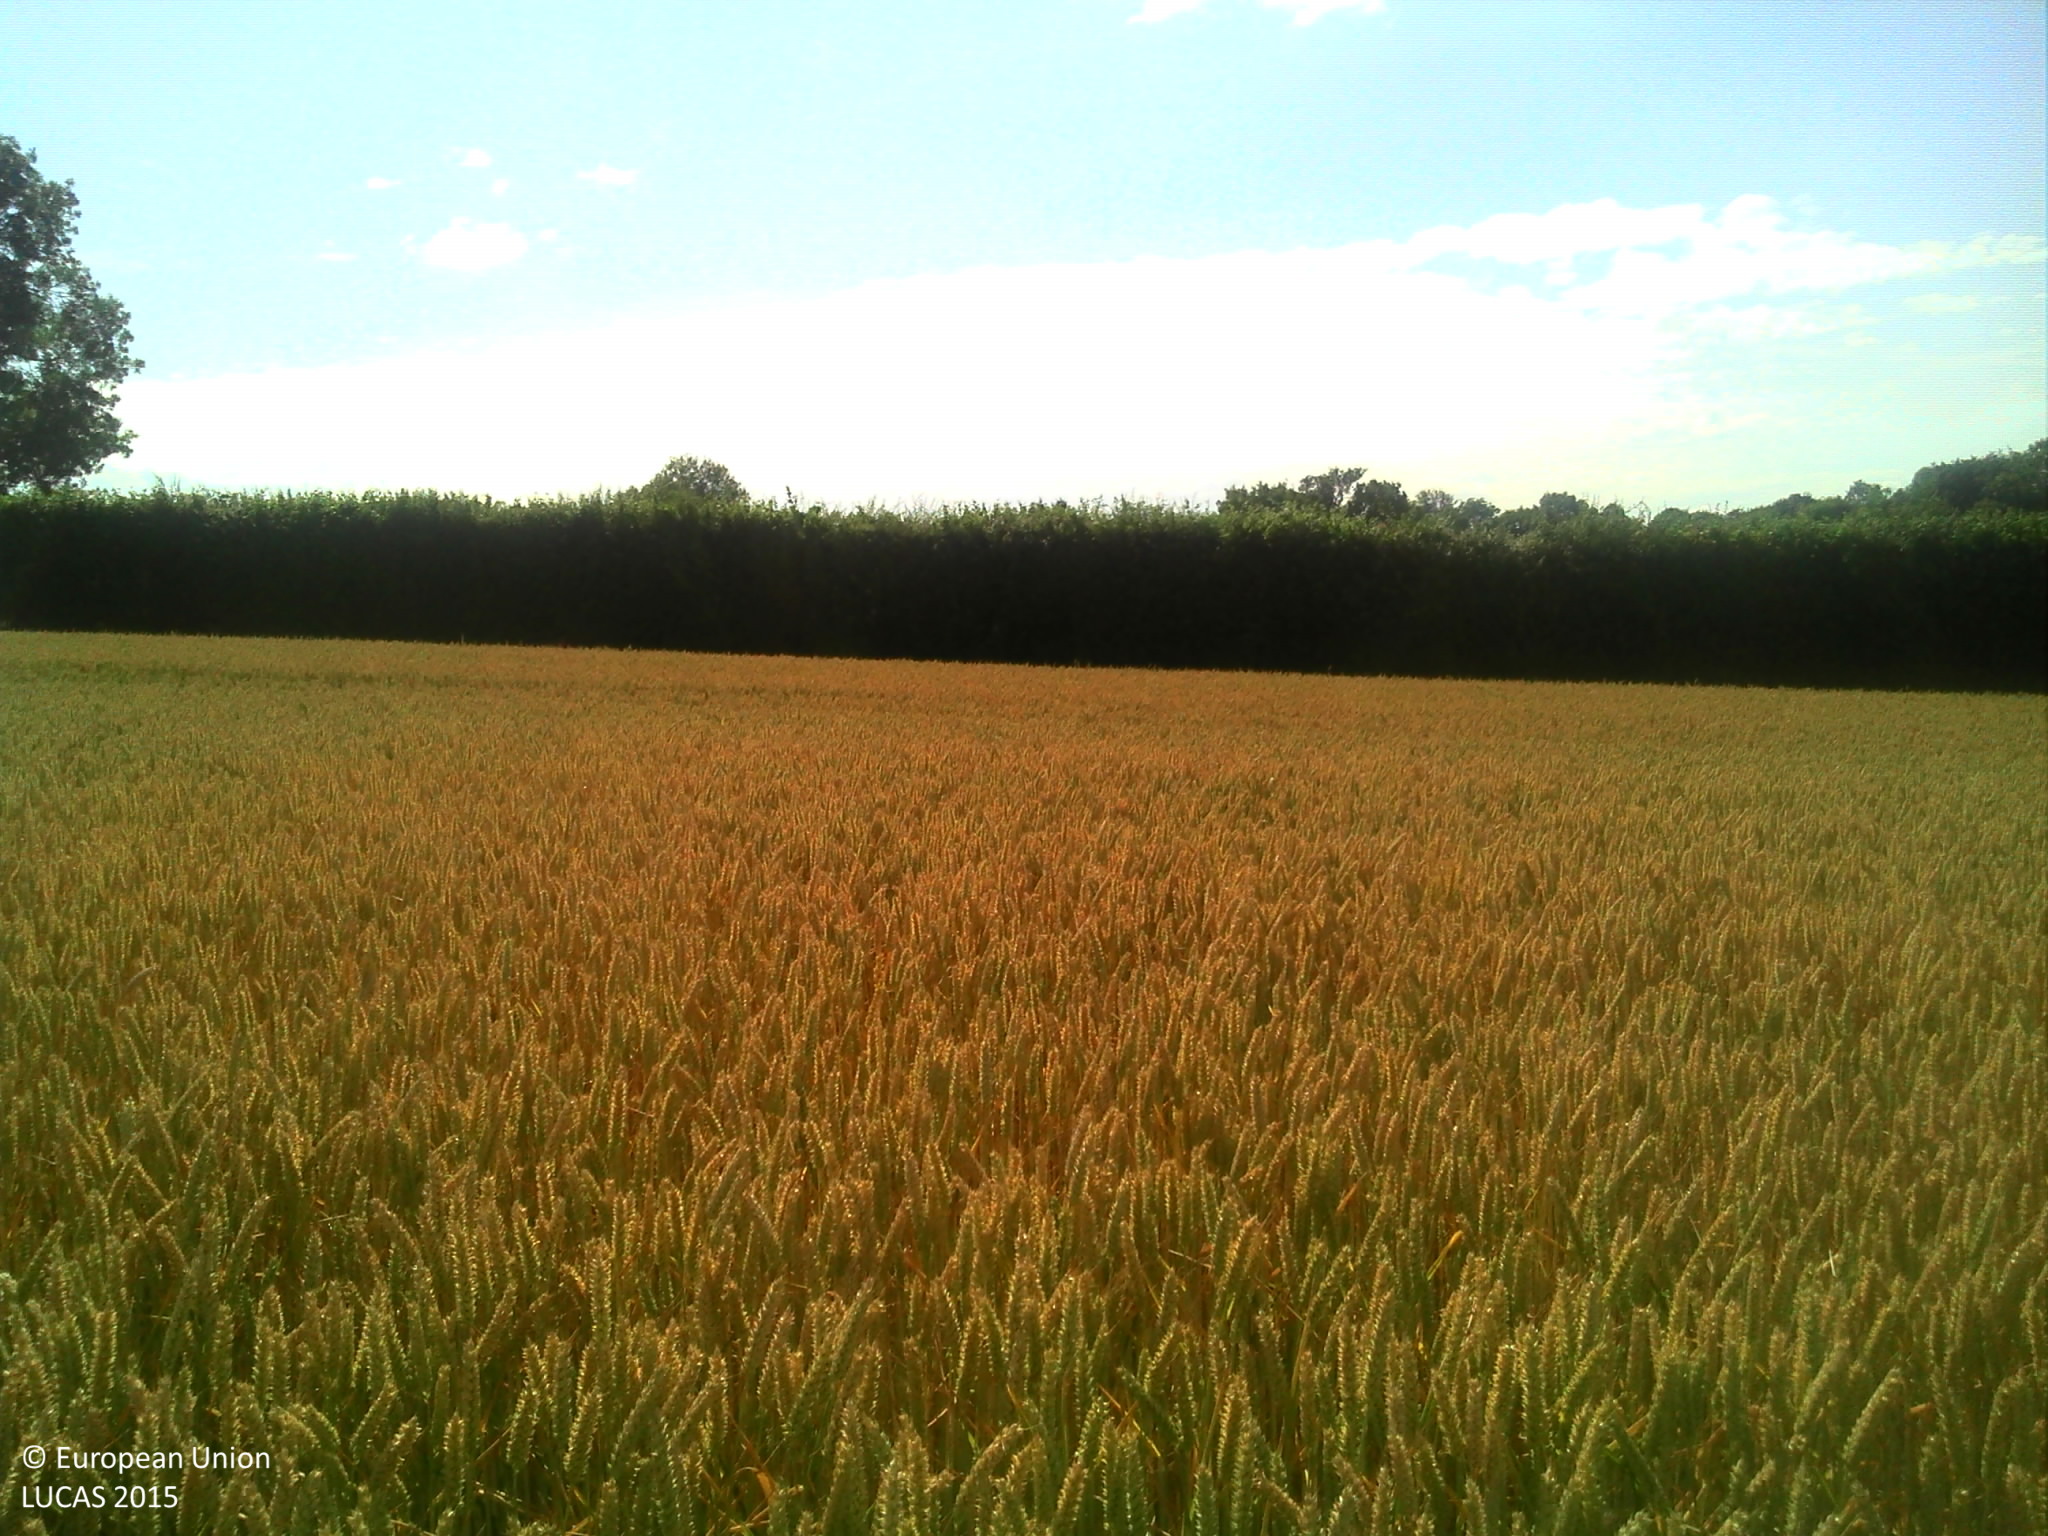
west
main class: Cropland
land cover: Common wheat
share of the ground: > 75 %
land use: Agriculture (excluding fallow land and kitchen gardens)
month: July
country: FR
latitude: 48.7315
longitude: 0.4435
